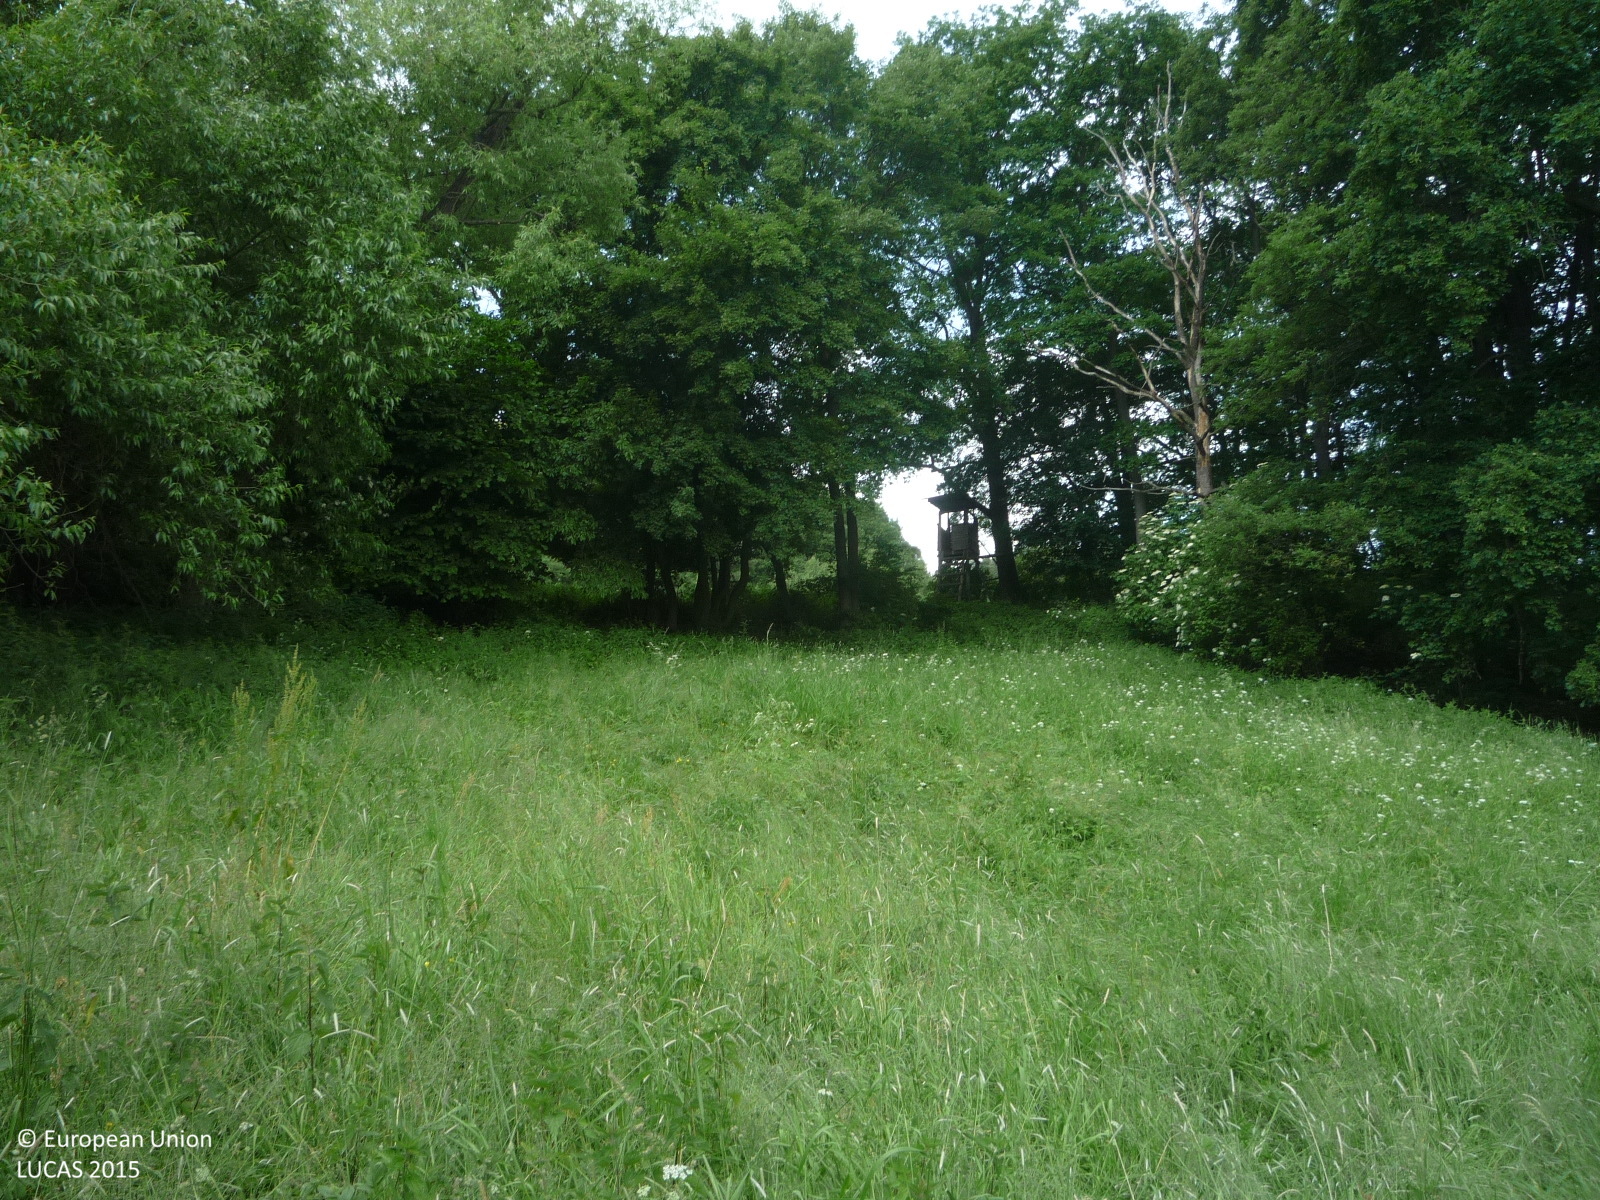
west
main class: Grassland
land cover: Grassland without tree/shrub cover
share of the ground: > 75 %
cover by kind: herbaceous plants 100 %
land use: Agriculture (excluding fallow land and kitchen gardens)
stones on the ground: < 10 %
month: June
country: CZ
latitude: 50.5793
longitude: 14.0824
